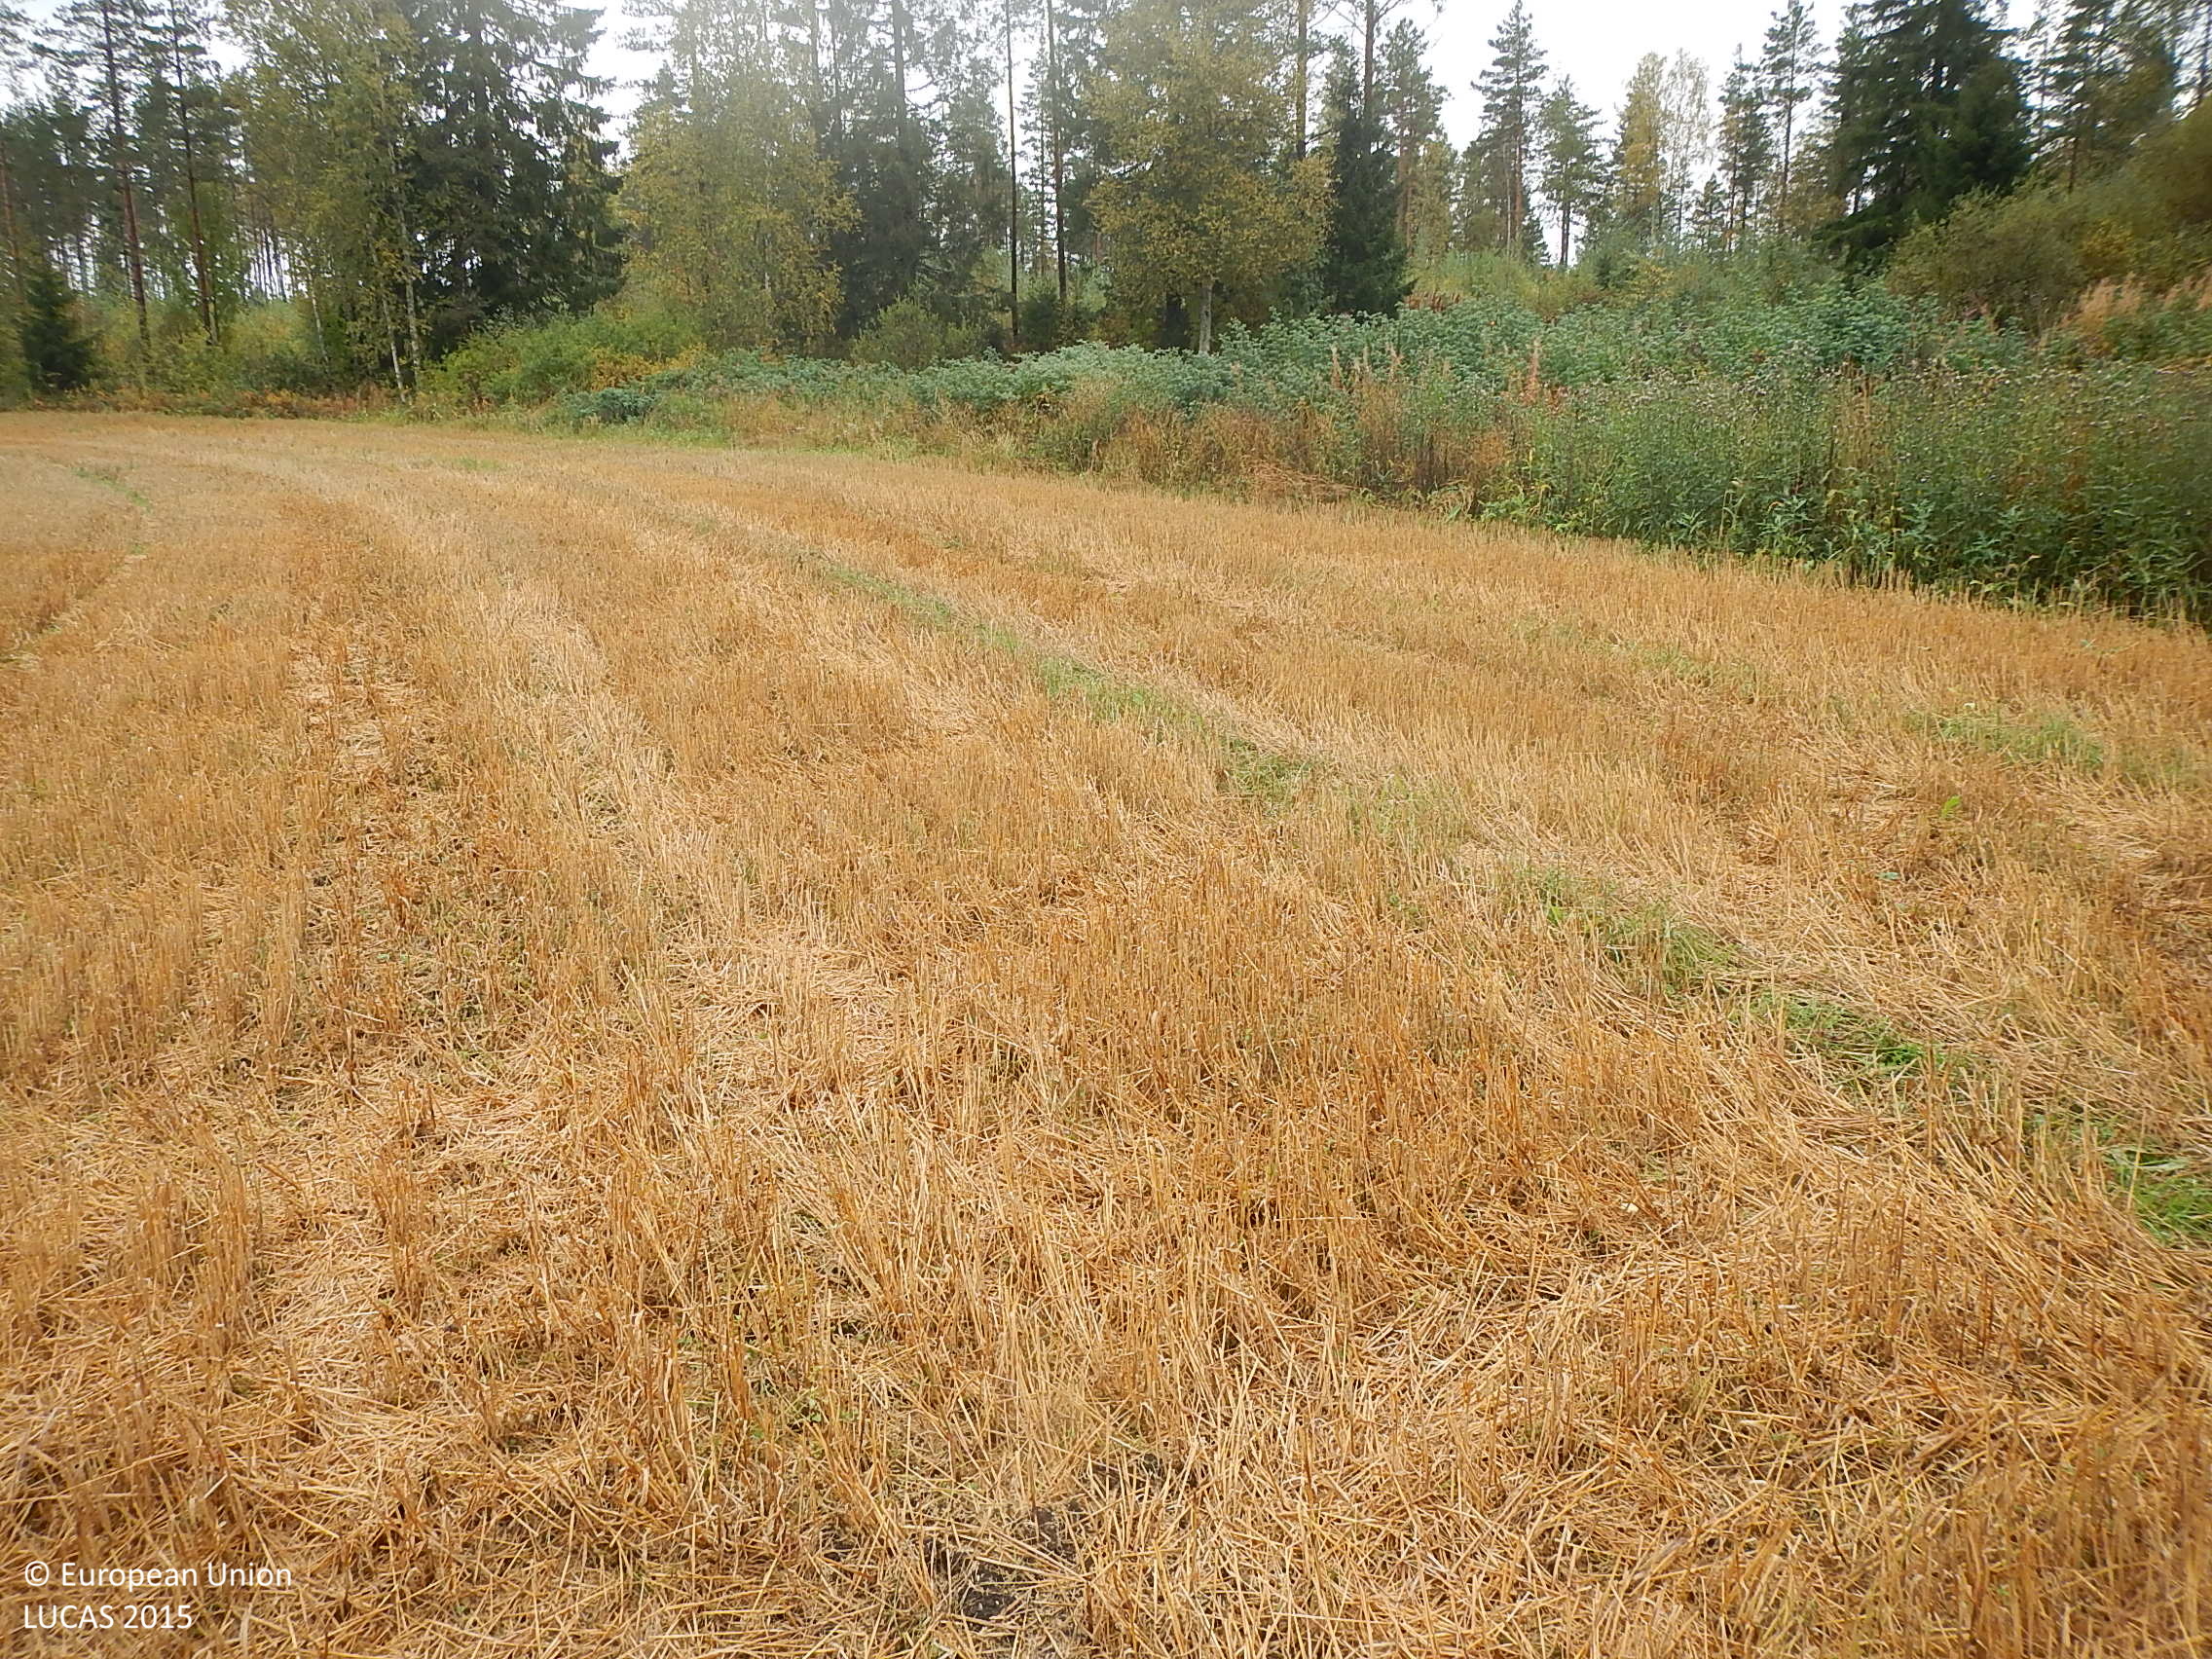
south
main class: Cropland
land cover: Barley
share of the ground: > 75 %
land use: Agriculture (excluding fallow land and kitchen gardens)
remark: Harvested field
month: September
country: FI
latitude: 61.8696
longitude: 22.2828
